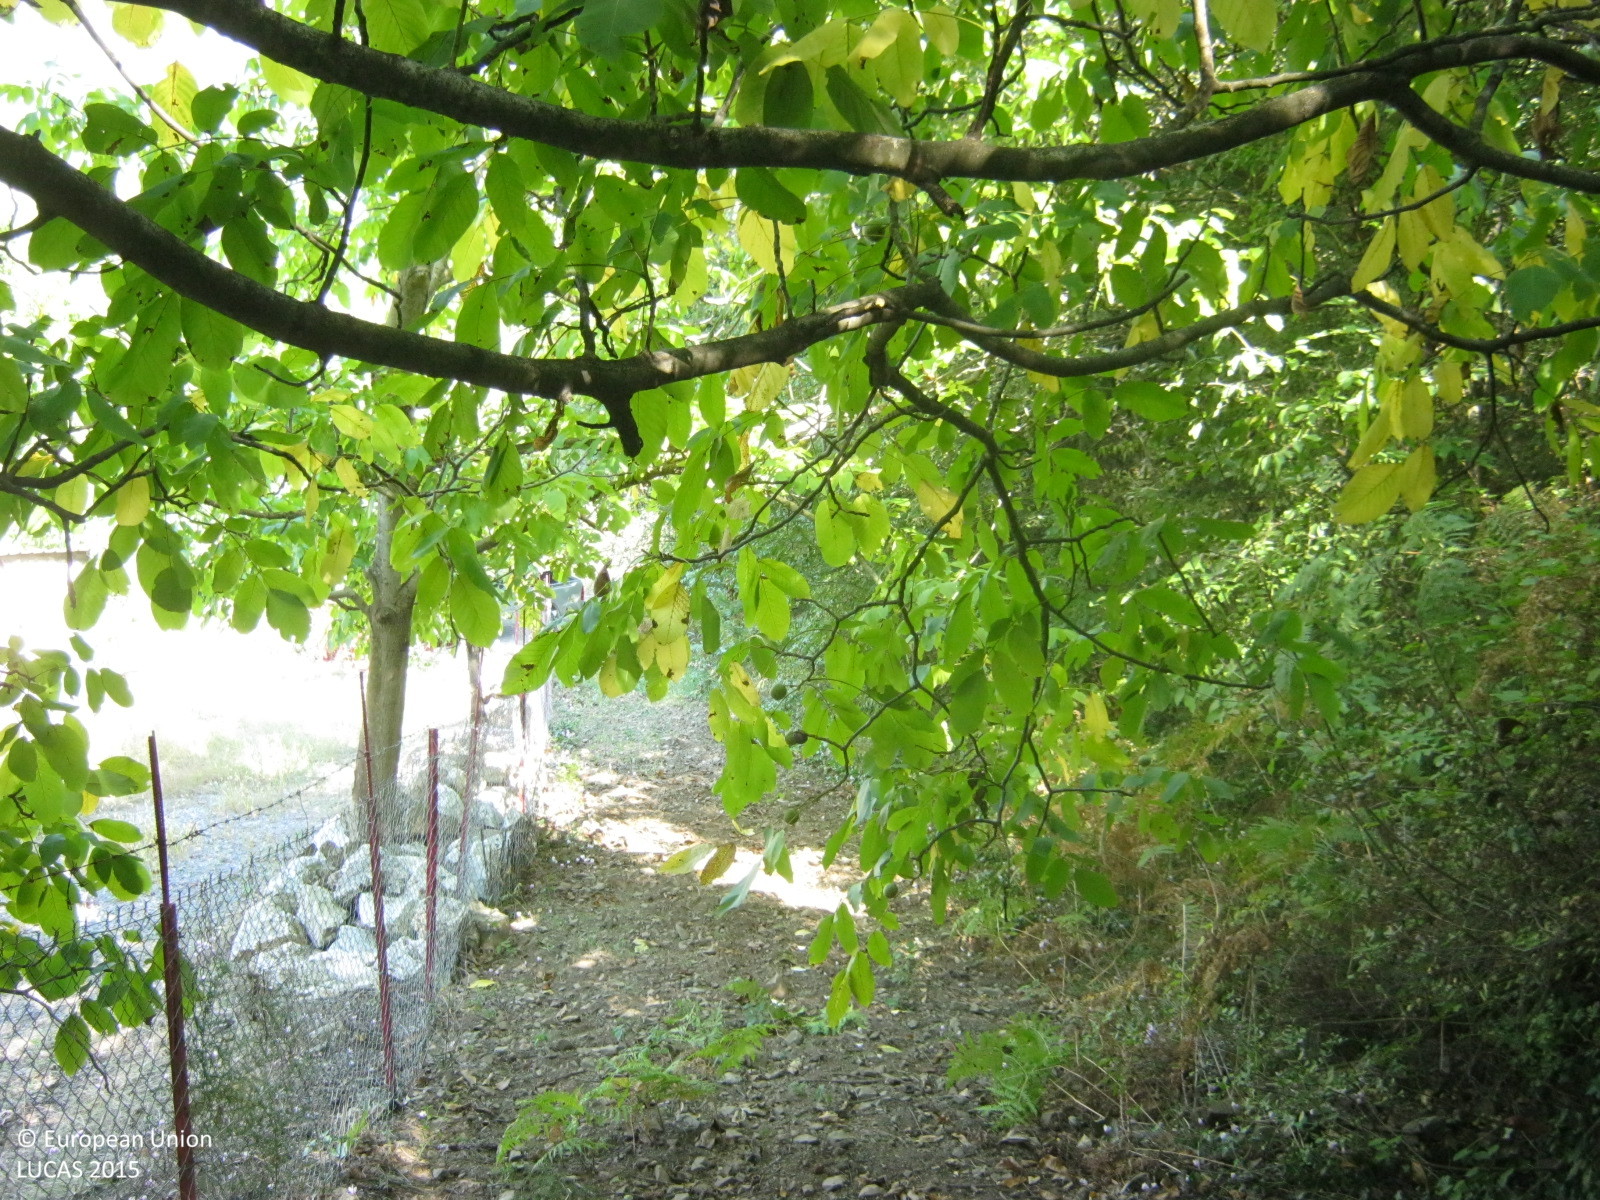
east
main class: Woodland
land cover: Broadleaved woodland
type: thermophilous deciduous forest
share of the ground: > 75 %
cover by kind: broadleaved forest trees 100 %
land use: Semi-natural and natural areas not in use
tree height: > 5 m
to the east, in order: Broadleaved woodland; Rivers and streams; Paved roads, cycling and walking lanes; Olive groves; Abandoned hedges; Broadleaved woodland
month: September
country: GR
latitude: 37.5656
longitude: 22.0404
